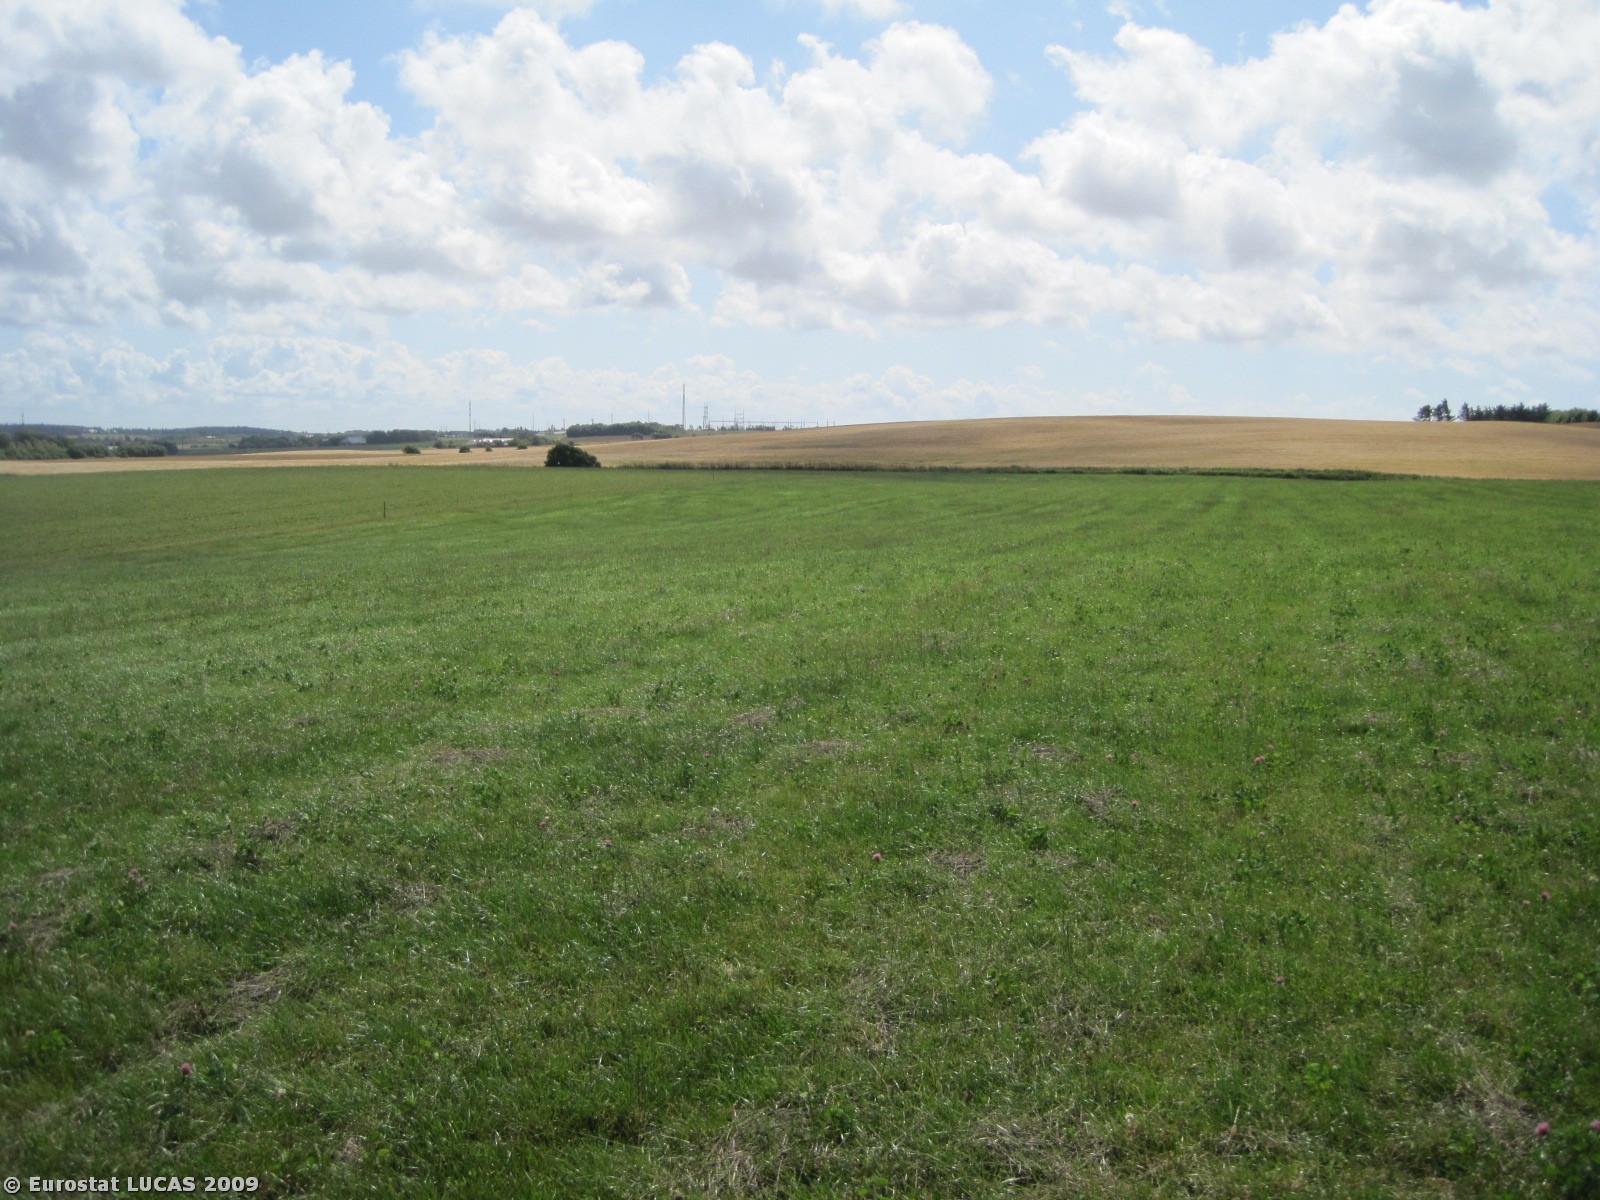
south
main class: Grassland
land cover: Grassland without tree/shrub cover
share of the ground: > 75 %
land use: Agriculture (excluding fallow land and kitchen gardens)
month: July
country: DK
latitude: 56.8252
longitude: 8.4127
